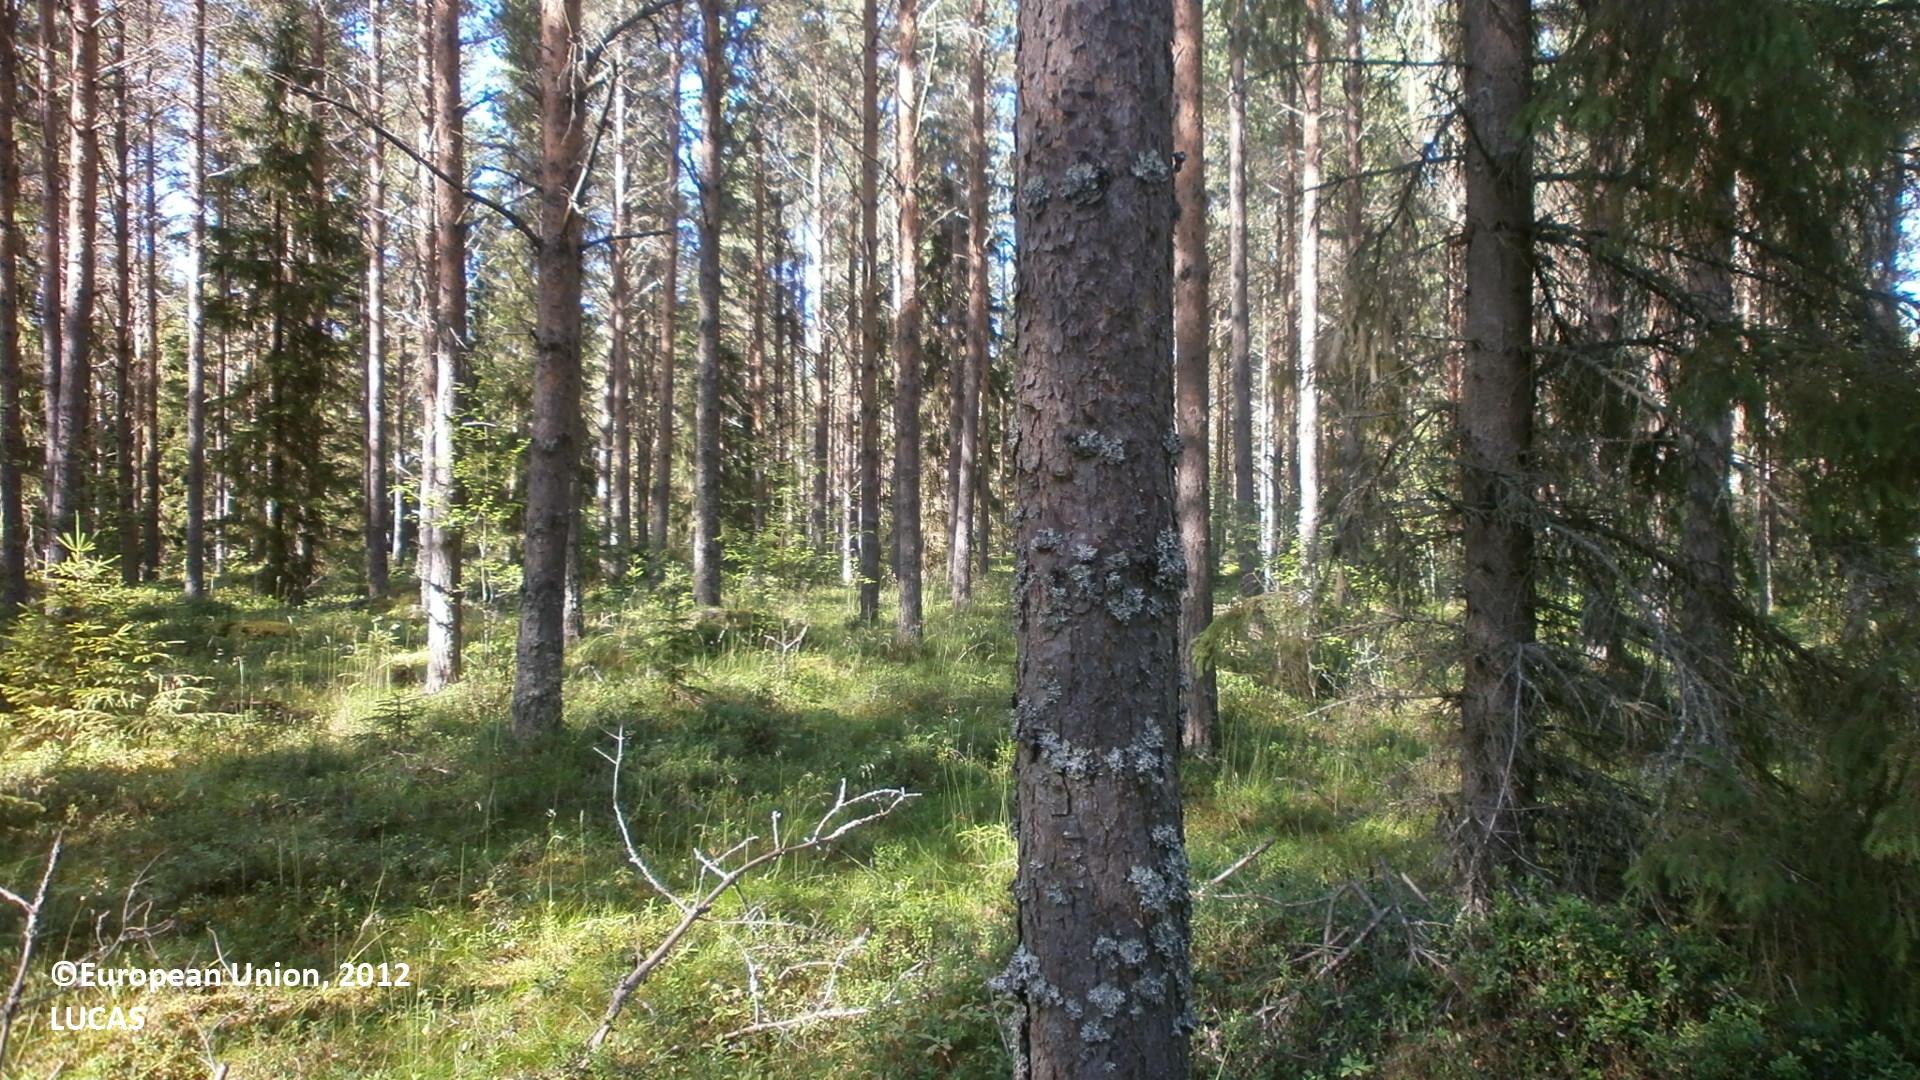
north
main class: Woodland
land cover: Pine dominated coniferous woodland
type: boreal forest
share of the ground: 50 - 75 %
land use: Forestry
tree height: > 5 m
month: July
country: FI
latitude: 64.3023
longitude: 24.0563
